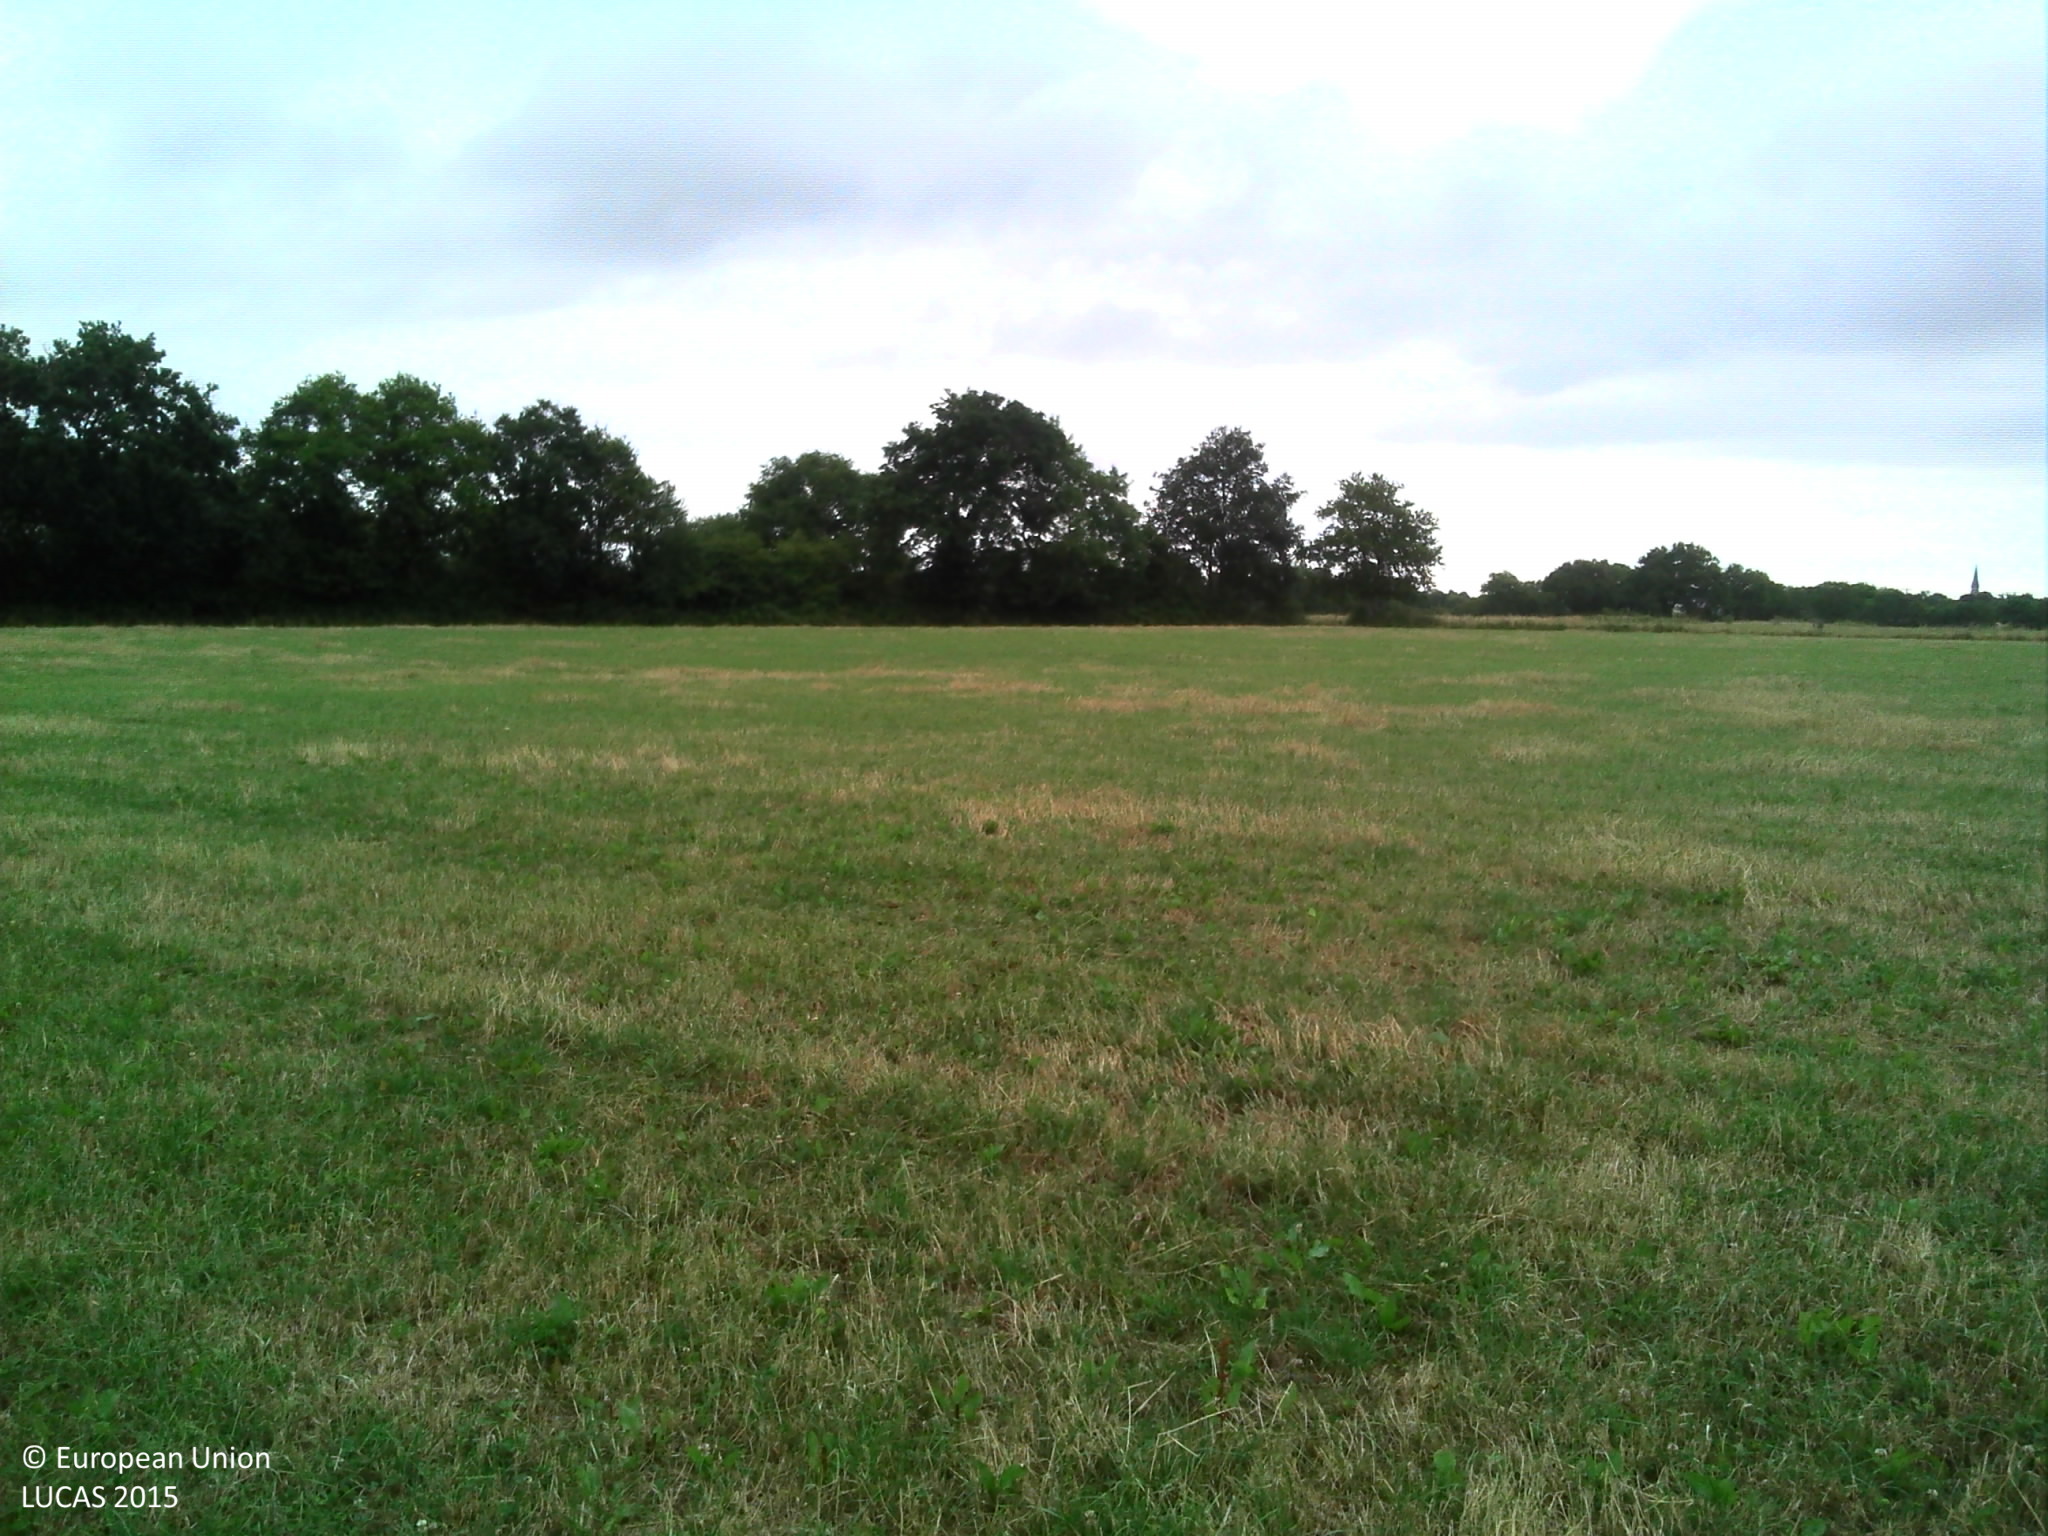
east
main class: Cropland
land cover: Temporary grasslands
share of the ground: > 75 %
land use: Agriculture (excluding fallow land and kitchen gardens)
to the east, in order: Temporary grasslands; Broadleaved woodland; Fences; Grassland without tree/shrub cover
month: July
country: FR
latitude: 47.1101
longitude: -1.8399
